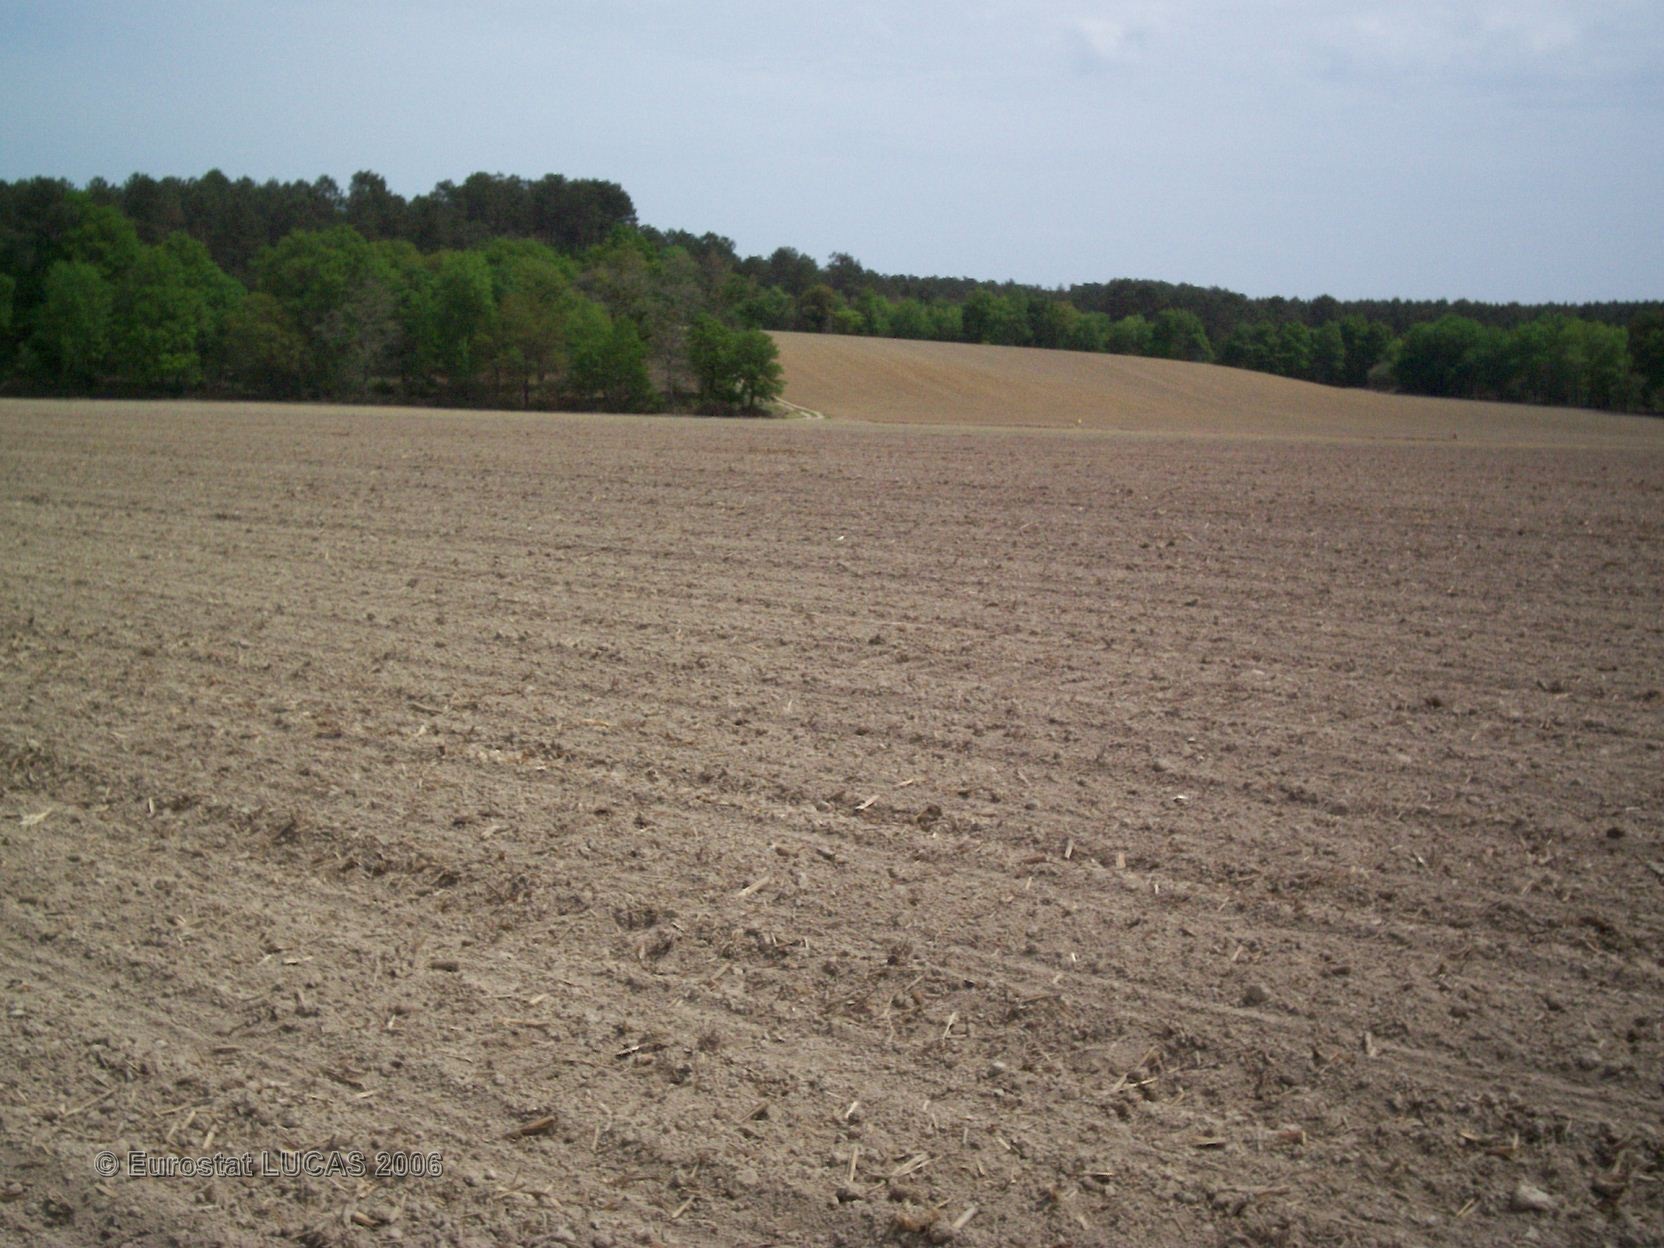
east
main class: Cropland
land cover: Maize
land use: Agriculture (excluding fallow land and kitchen gardens)
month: May
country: FR
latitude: 43.7861
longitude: -0.2609
